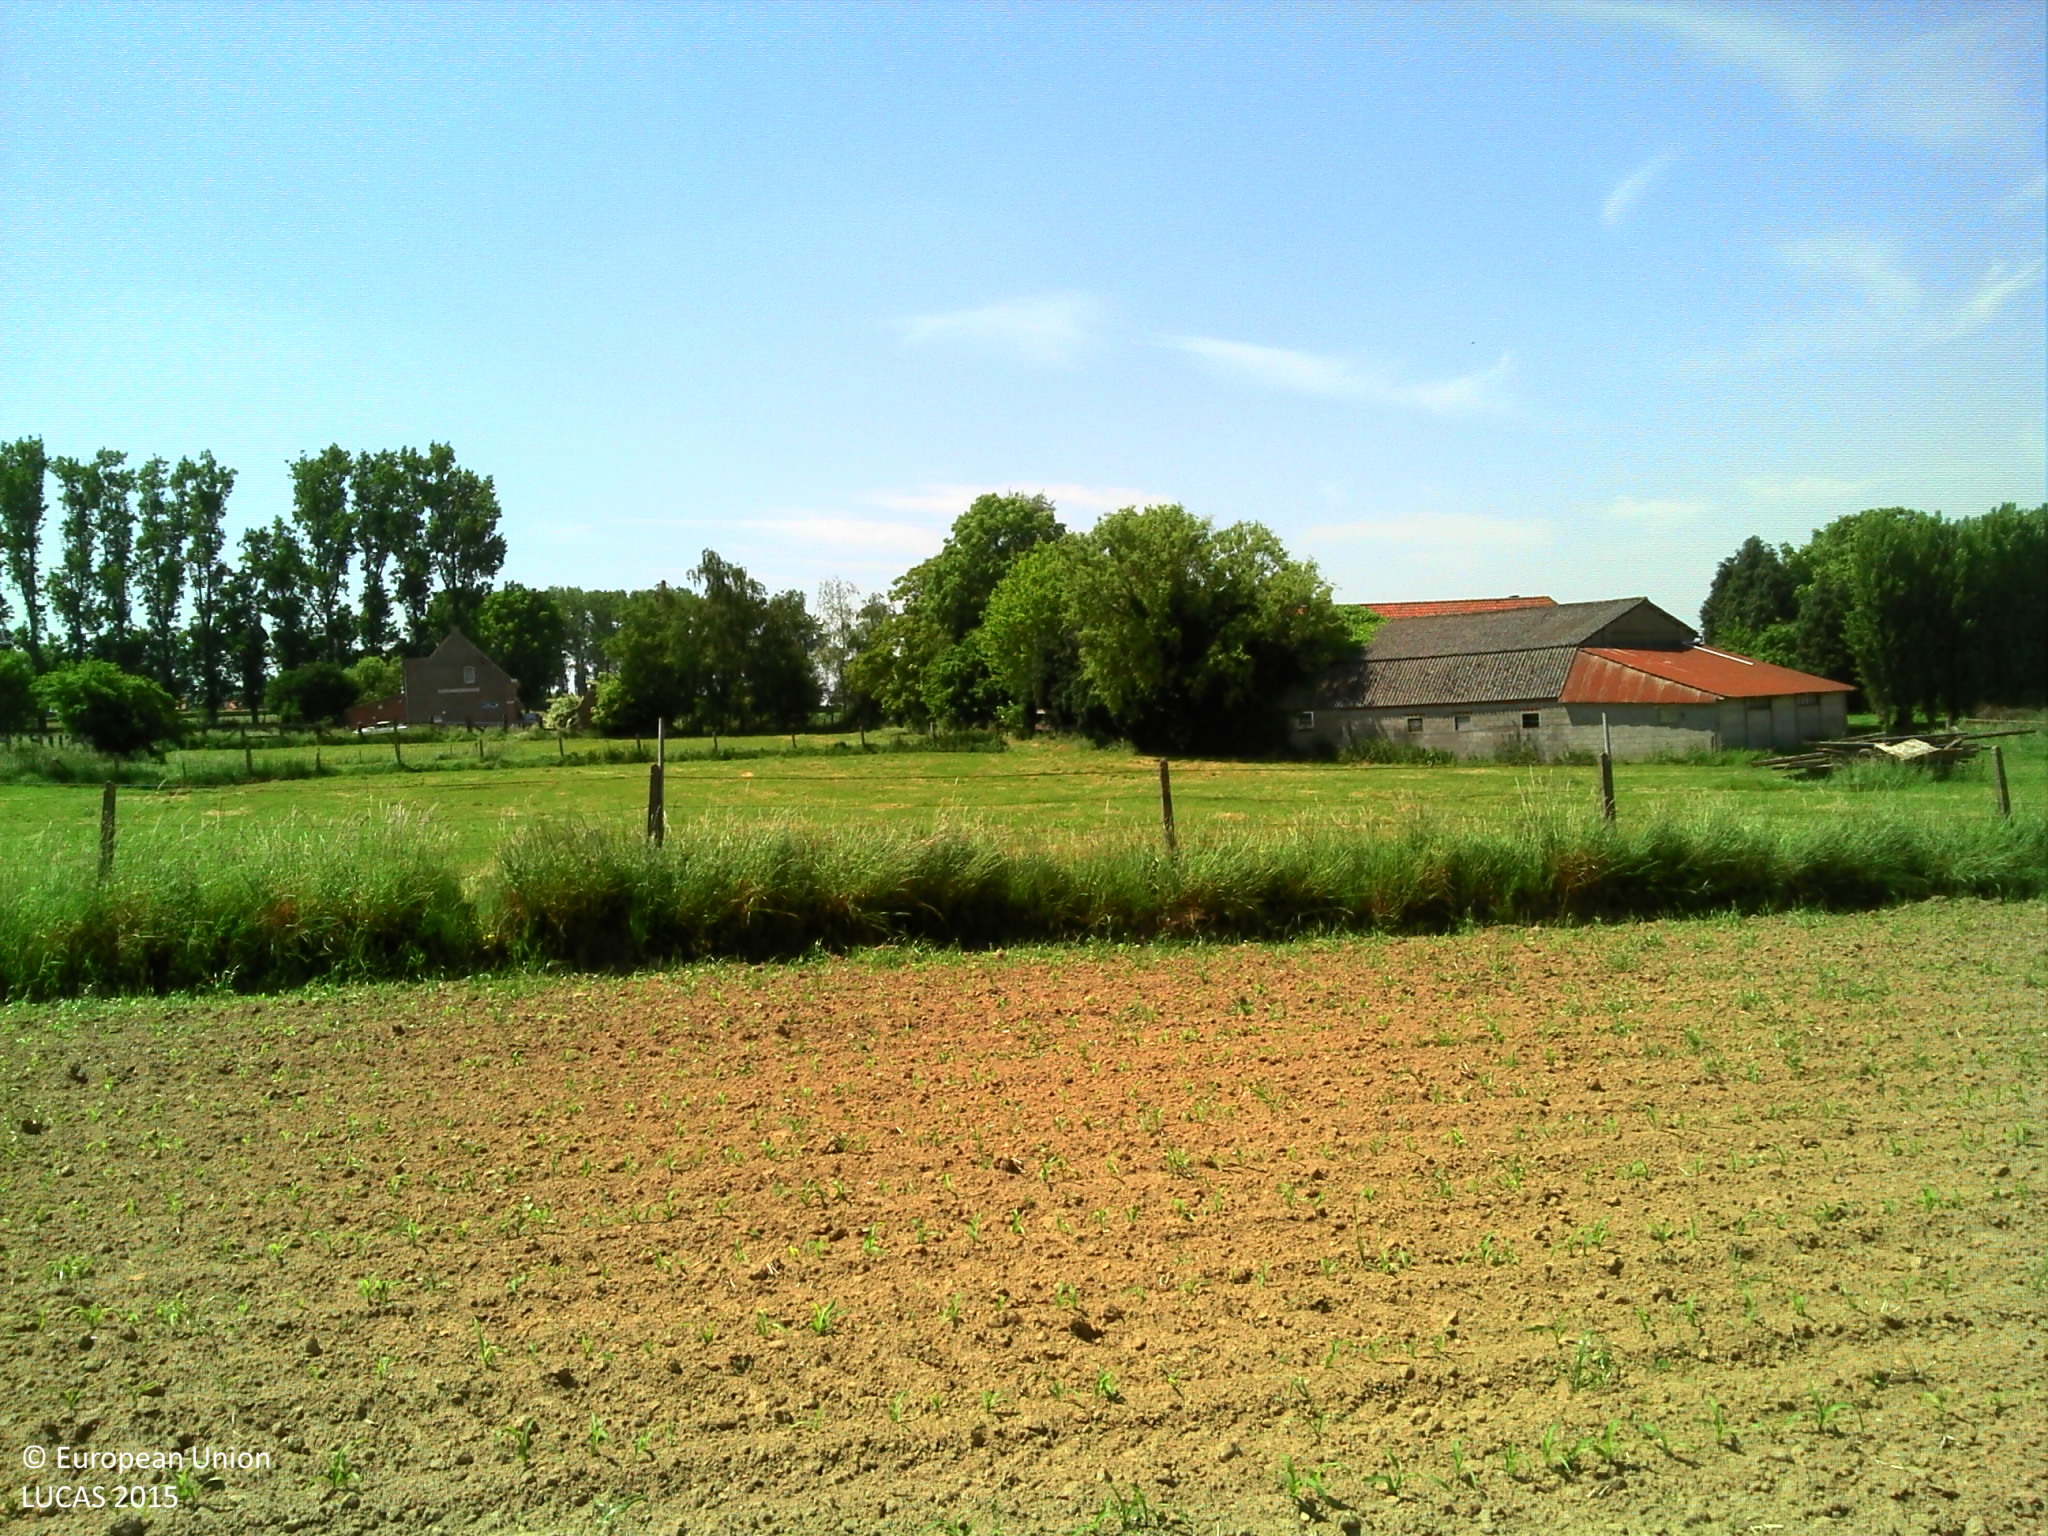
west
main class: Cropland
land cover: Maize
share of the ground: 10 - 25 %
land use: Agriculture (excluding fallow land and kitchen gardens)
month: June
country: BE
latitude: 50.7955
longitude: 2.9385
